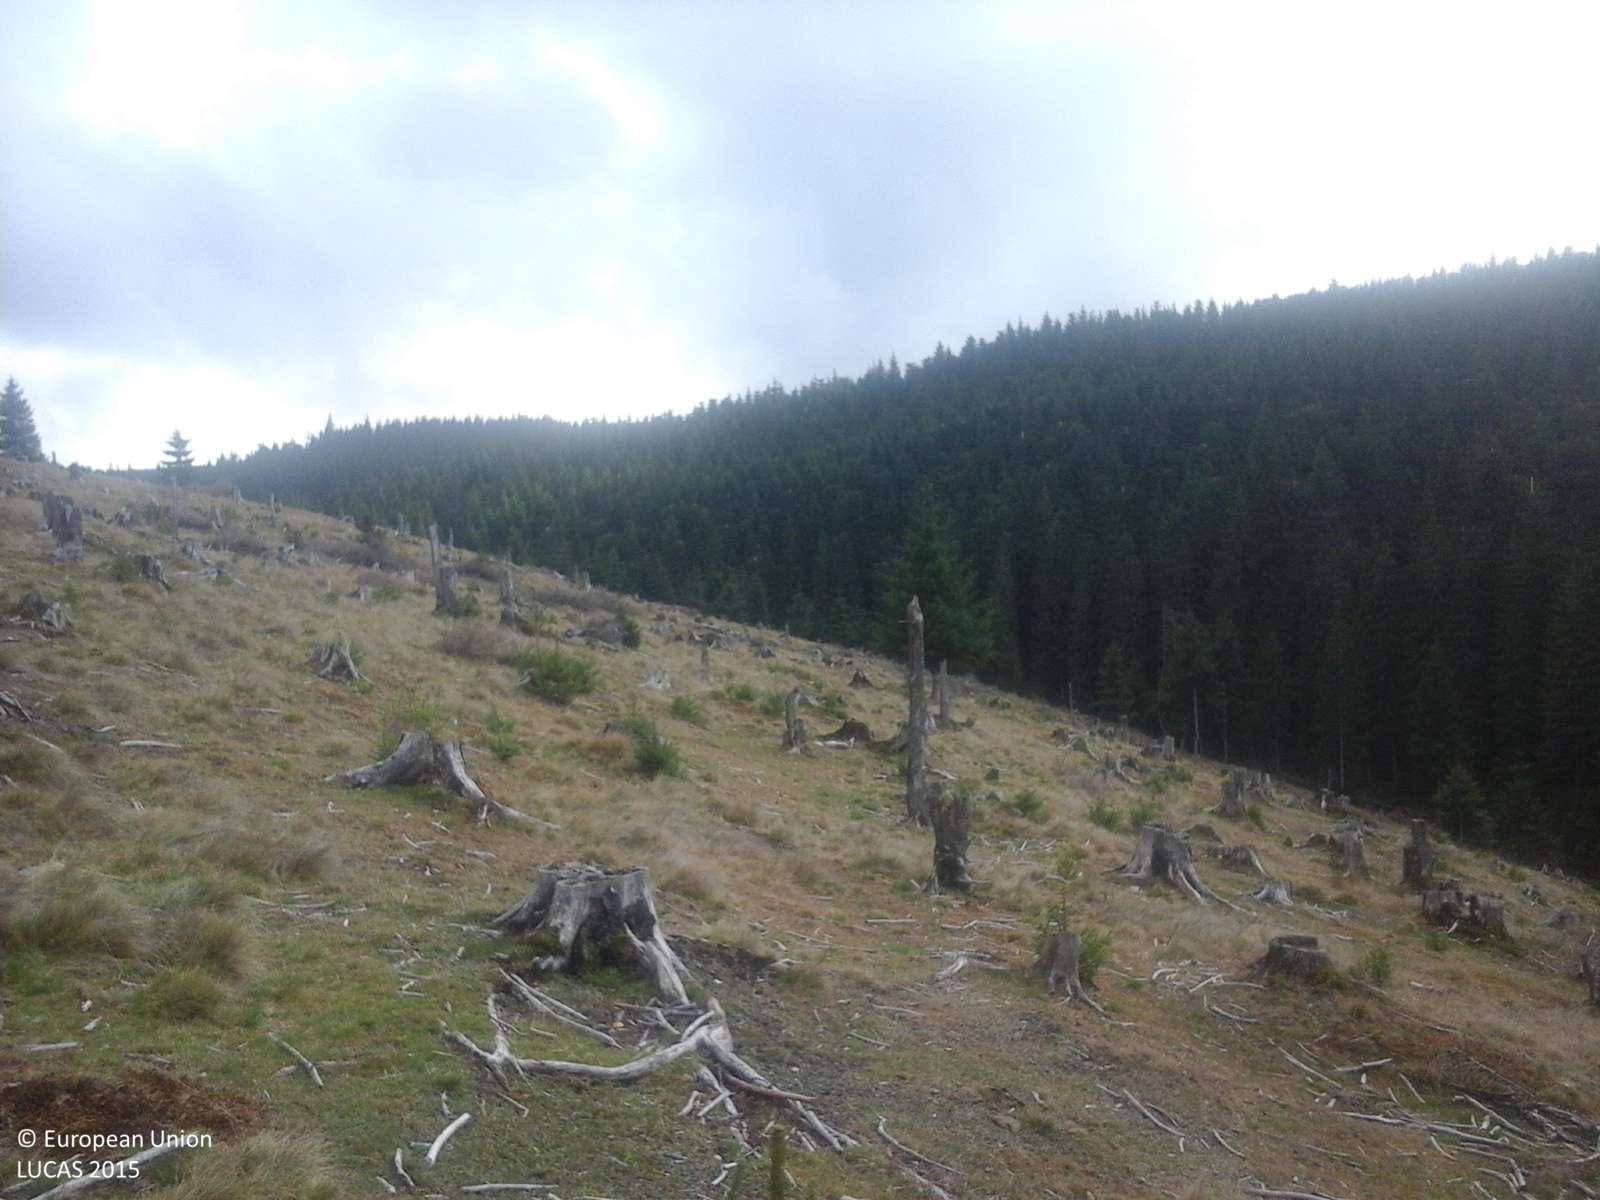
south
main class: Grassland
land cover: Grassland with sparse tree/shrub cover
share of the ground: > 75 %
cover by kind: herbaceous plants 85 %, shrubs 10 %, broadleaved forest trees 5 %
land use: Forestry
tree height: < 5 m
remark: Clear cut
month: October
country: RO
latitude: 46.5038
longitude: 26.0597
